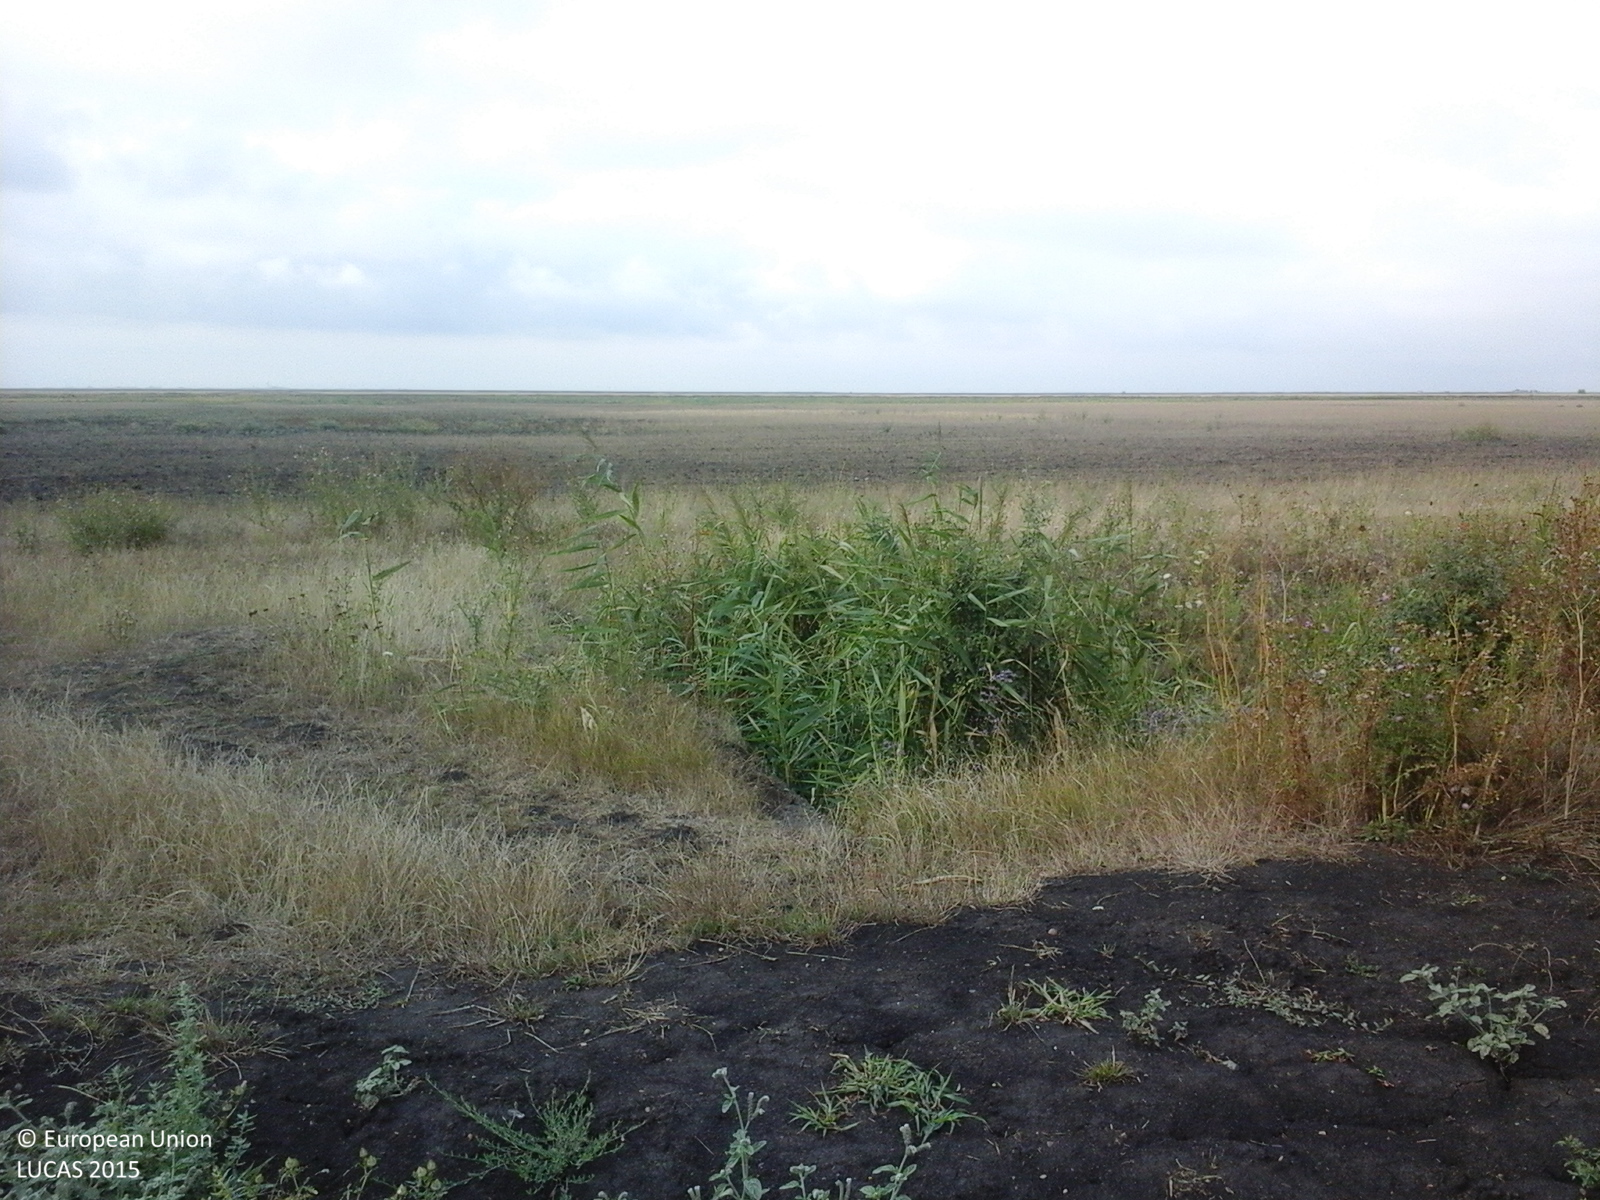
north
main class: Cropland
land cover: Maize
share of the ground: > 75 %
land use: Agriculture (excluding fallow land and kitchen gardens)
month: August
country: RO
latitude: 45.9587
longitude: 20.5141
